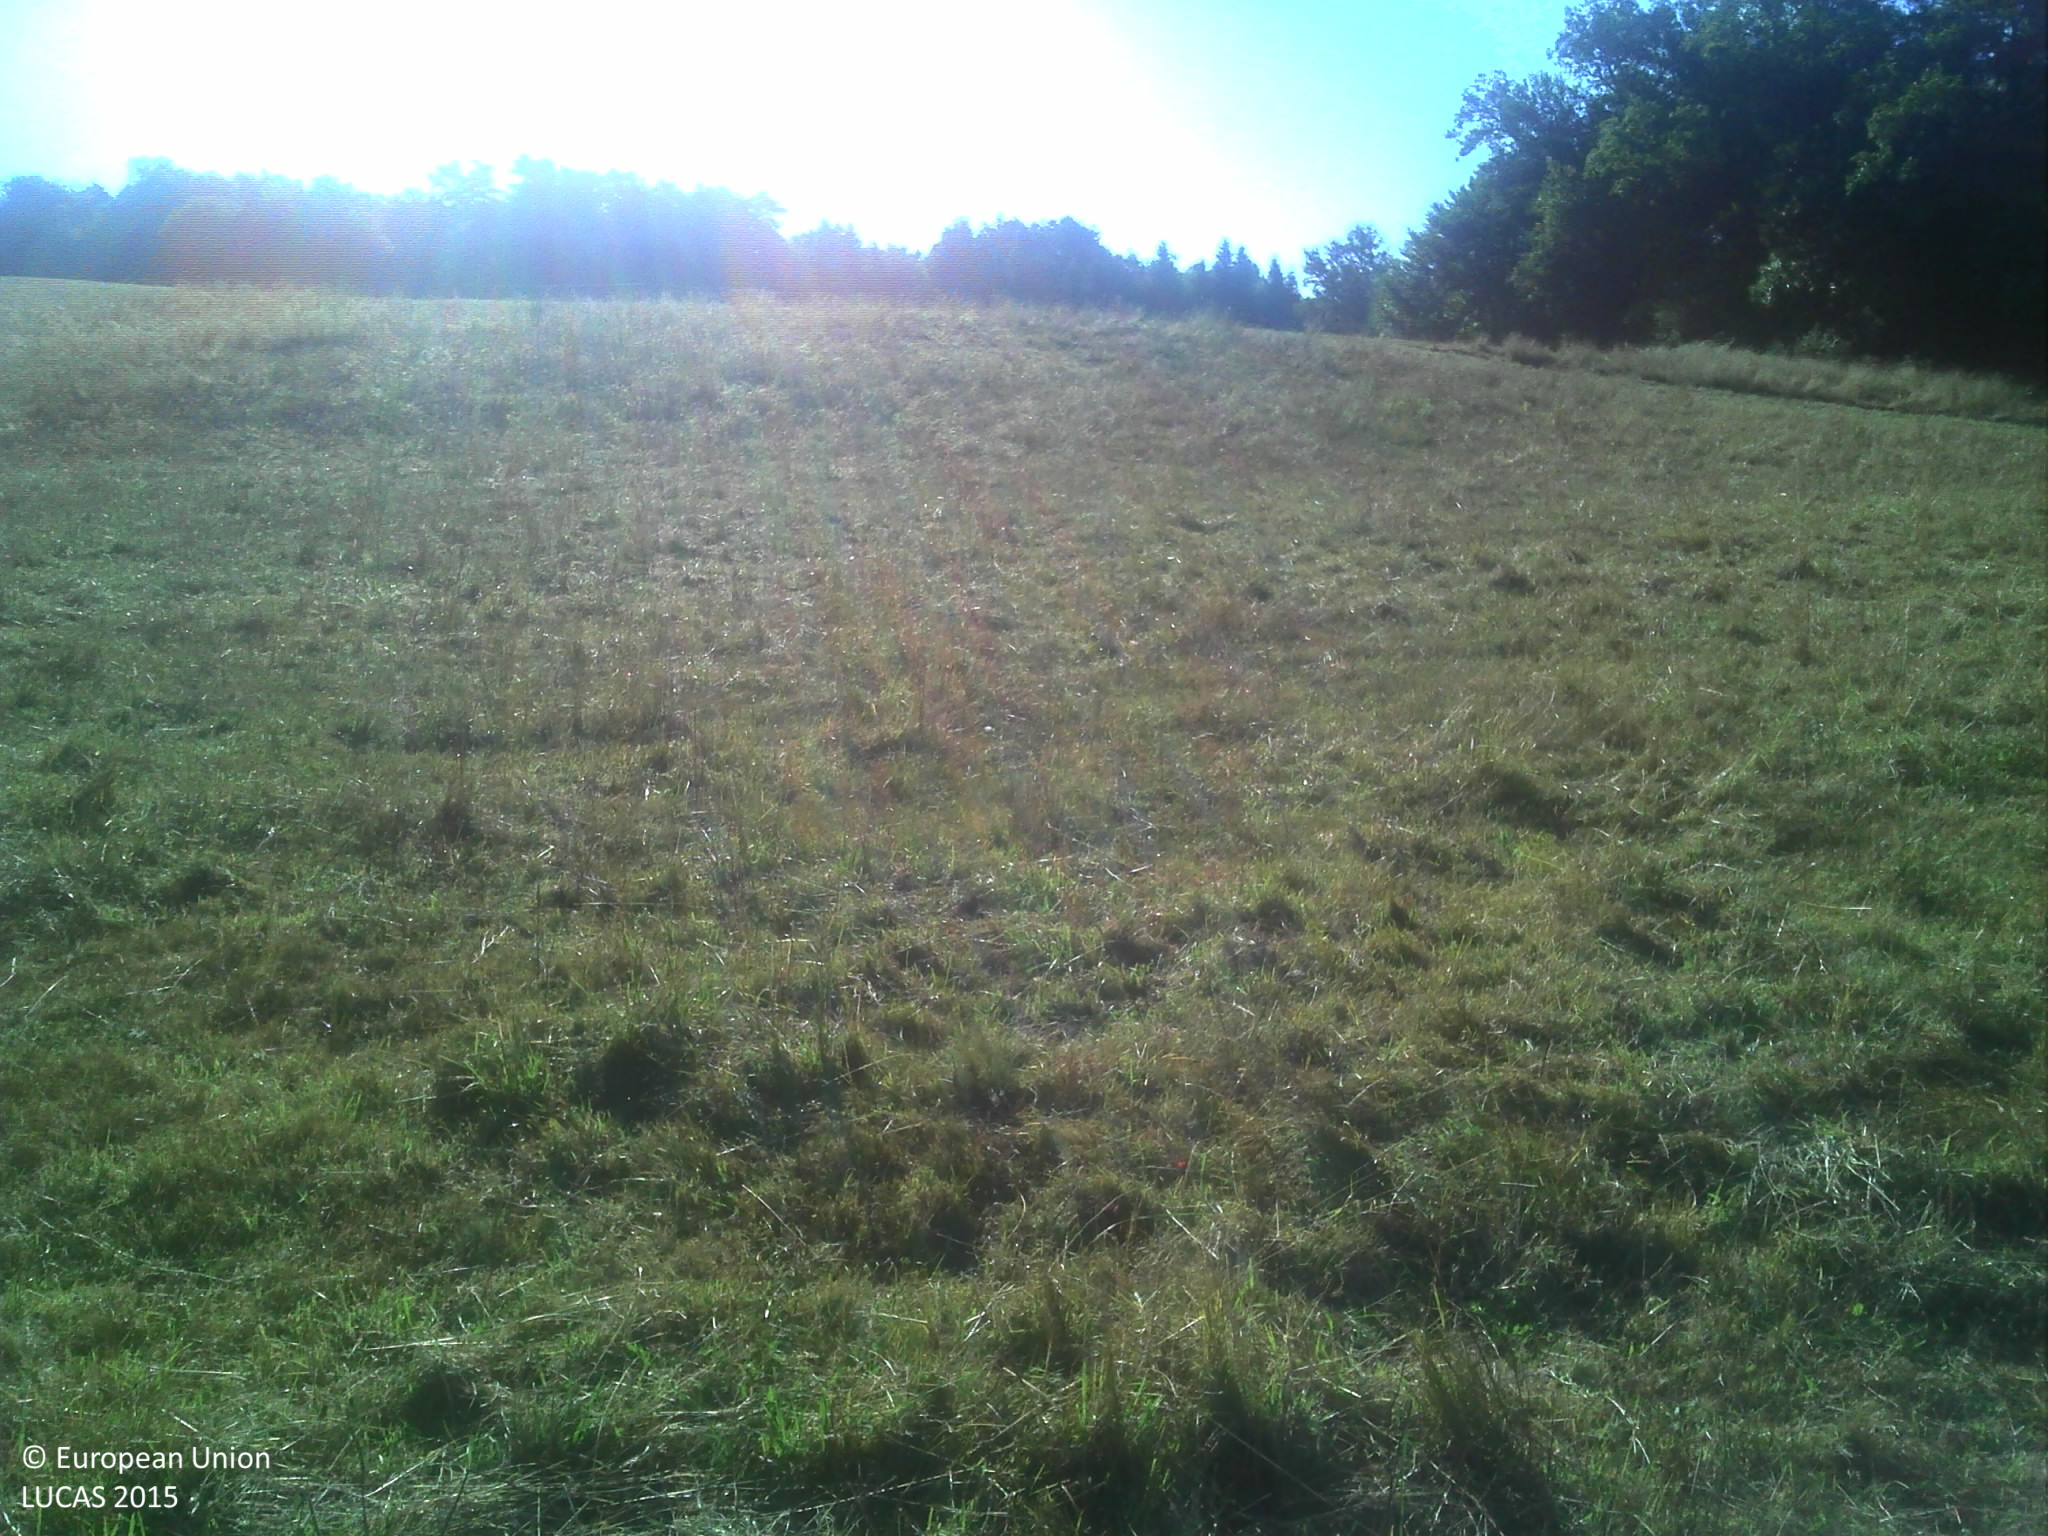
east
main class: Grassland
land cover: Grassland without tree/shrub cover
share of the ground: > 75 %
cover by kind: herbaceous plants 95 %, shrubs 5 %
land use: Agriculture (excluding fallow land and kitchen gardens)
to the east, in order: Rivers and streams; Fences; Grassland without tree/shrub cover; Fences; Grassland without tree/shrub cover; Other mixed woodland
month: August
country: FR
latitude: 45.3173
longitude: 1.8705
